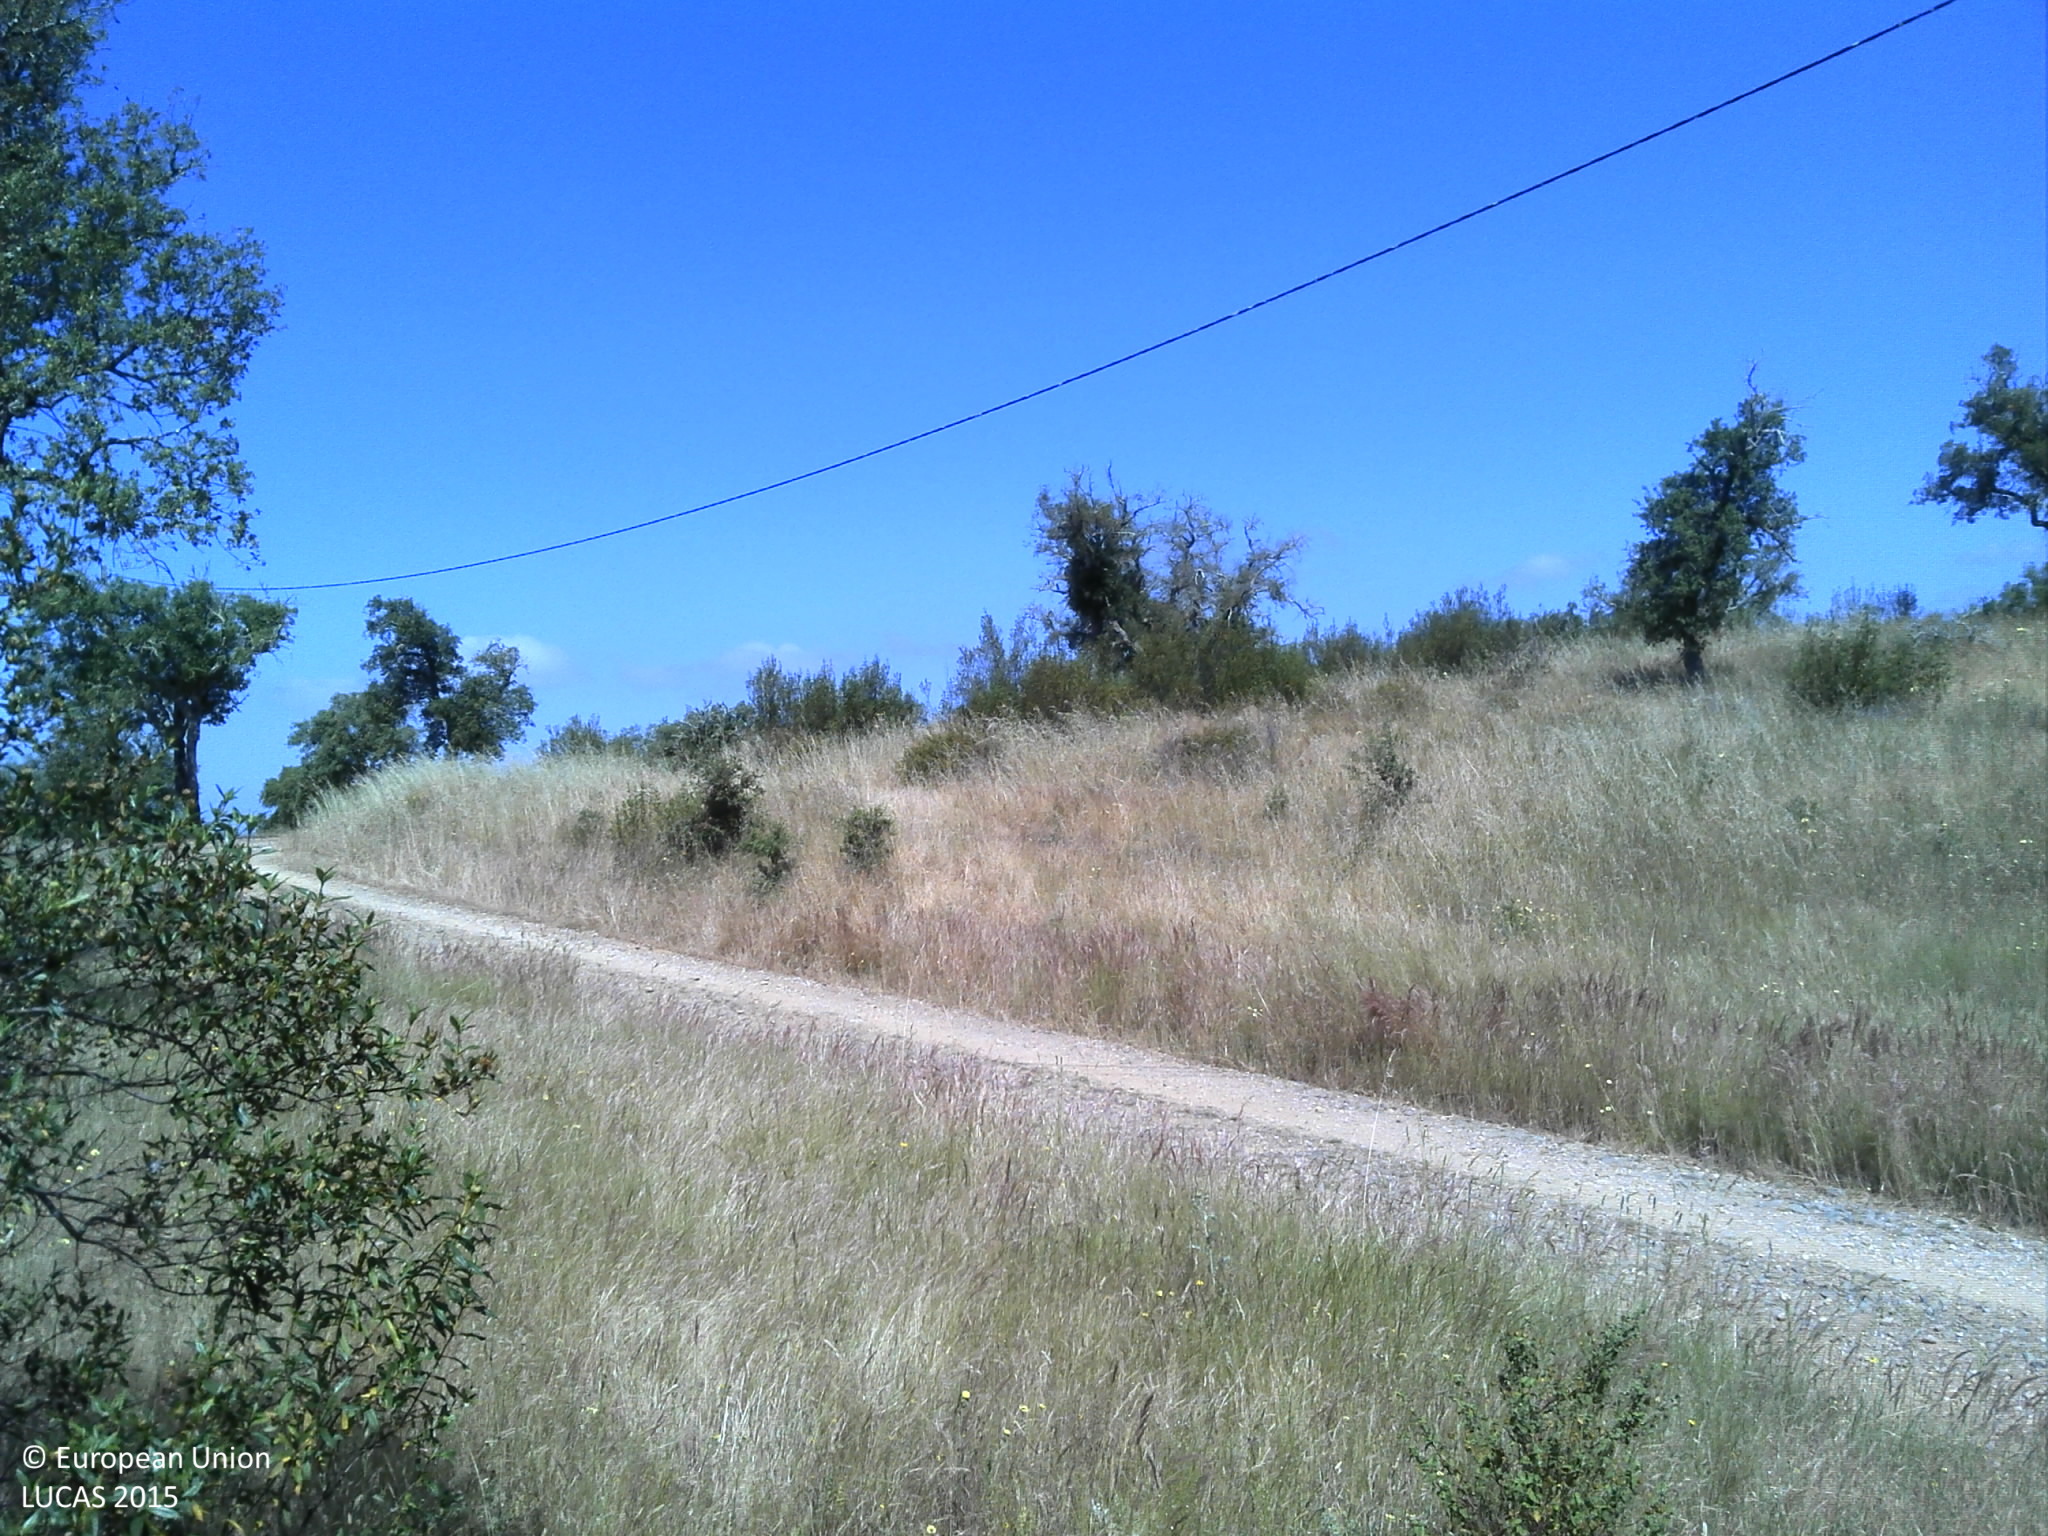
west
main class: Woodland
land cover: Broadleaved woodland
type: broadleaved evergreen forest
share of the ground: 25 - 50 %
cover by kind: broadleaved forest trees 40 %, herbaceous plants 30 %, unconsolidated bare surface 25 %, shrubs 5 %
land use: Forestry
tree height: > 5 m
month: May
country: PT
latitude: 38.1178
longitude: -8.6062
